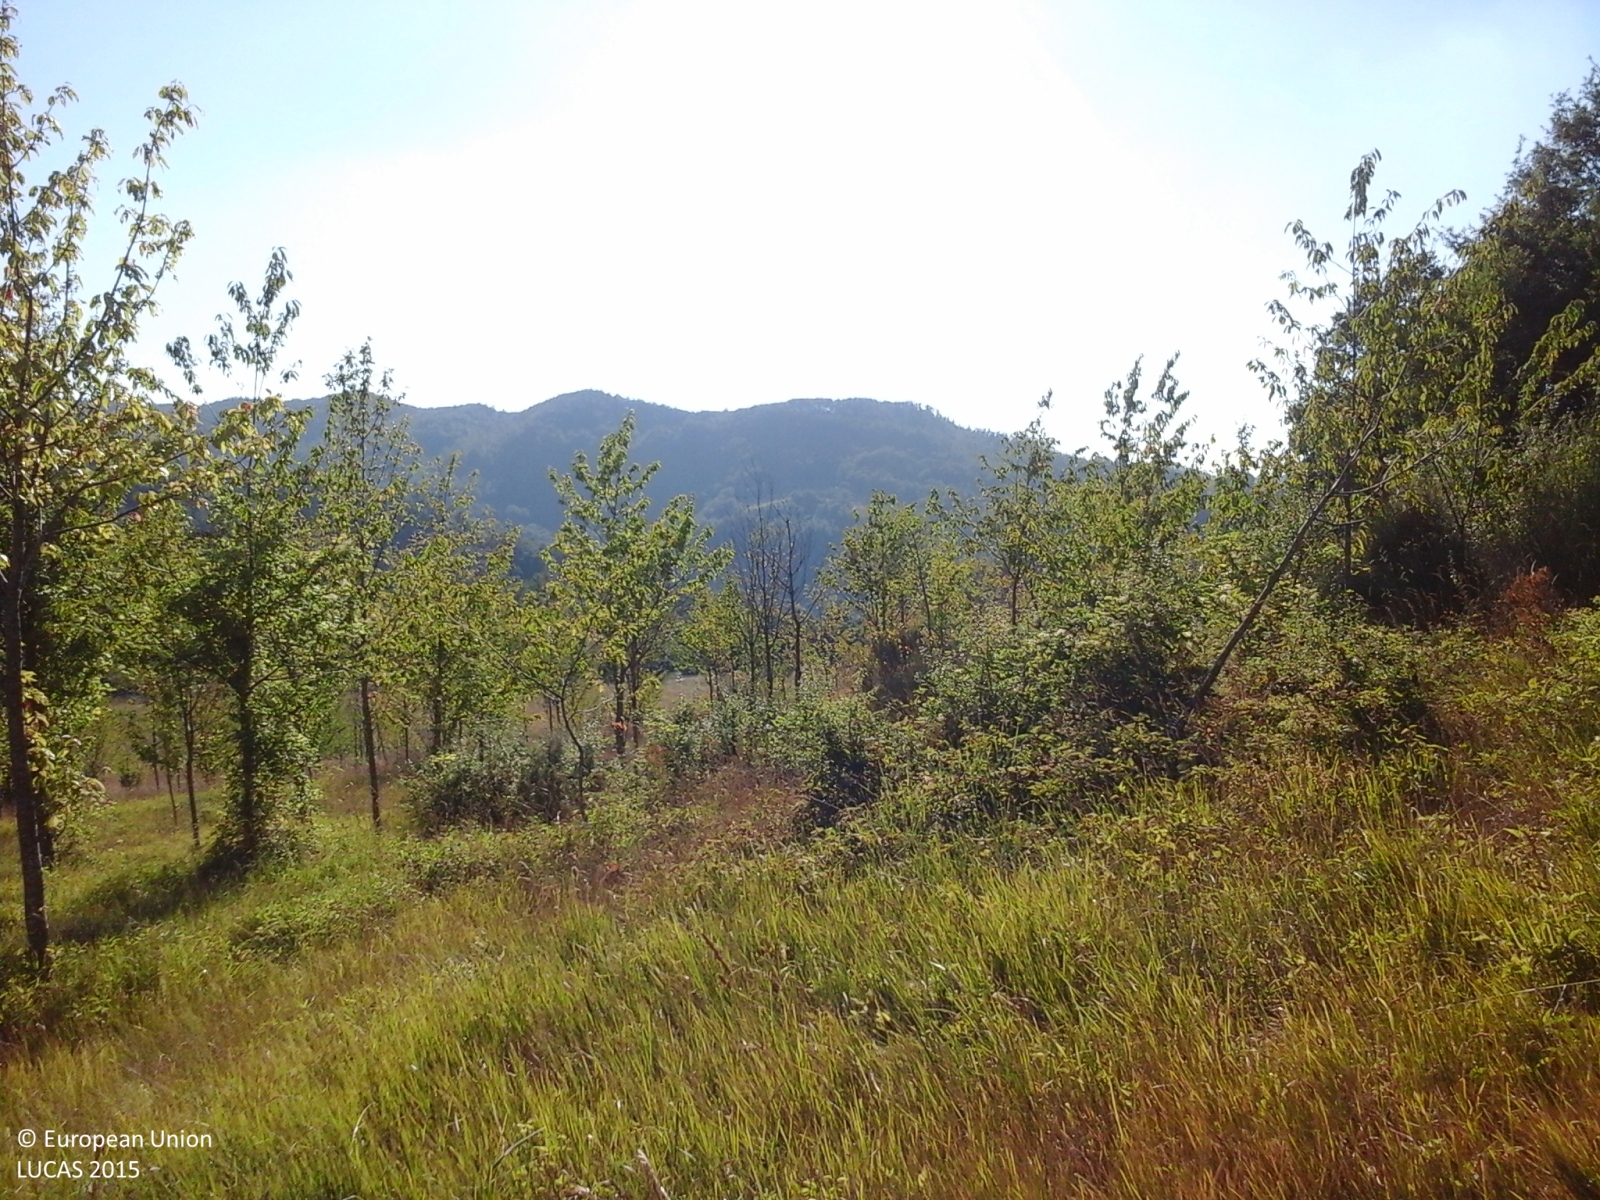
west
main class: Cropland
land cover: Nuts trees
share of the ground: 25 - 50 %
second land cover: Grassland without tree/shrub cover
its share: > 75 %
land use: Agriculture (excluding fallow land and kitchen gardens)
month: August
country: IT
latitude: 43.5279
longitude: 12.4312
